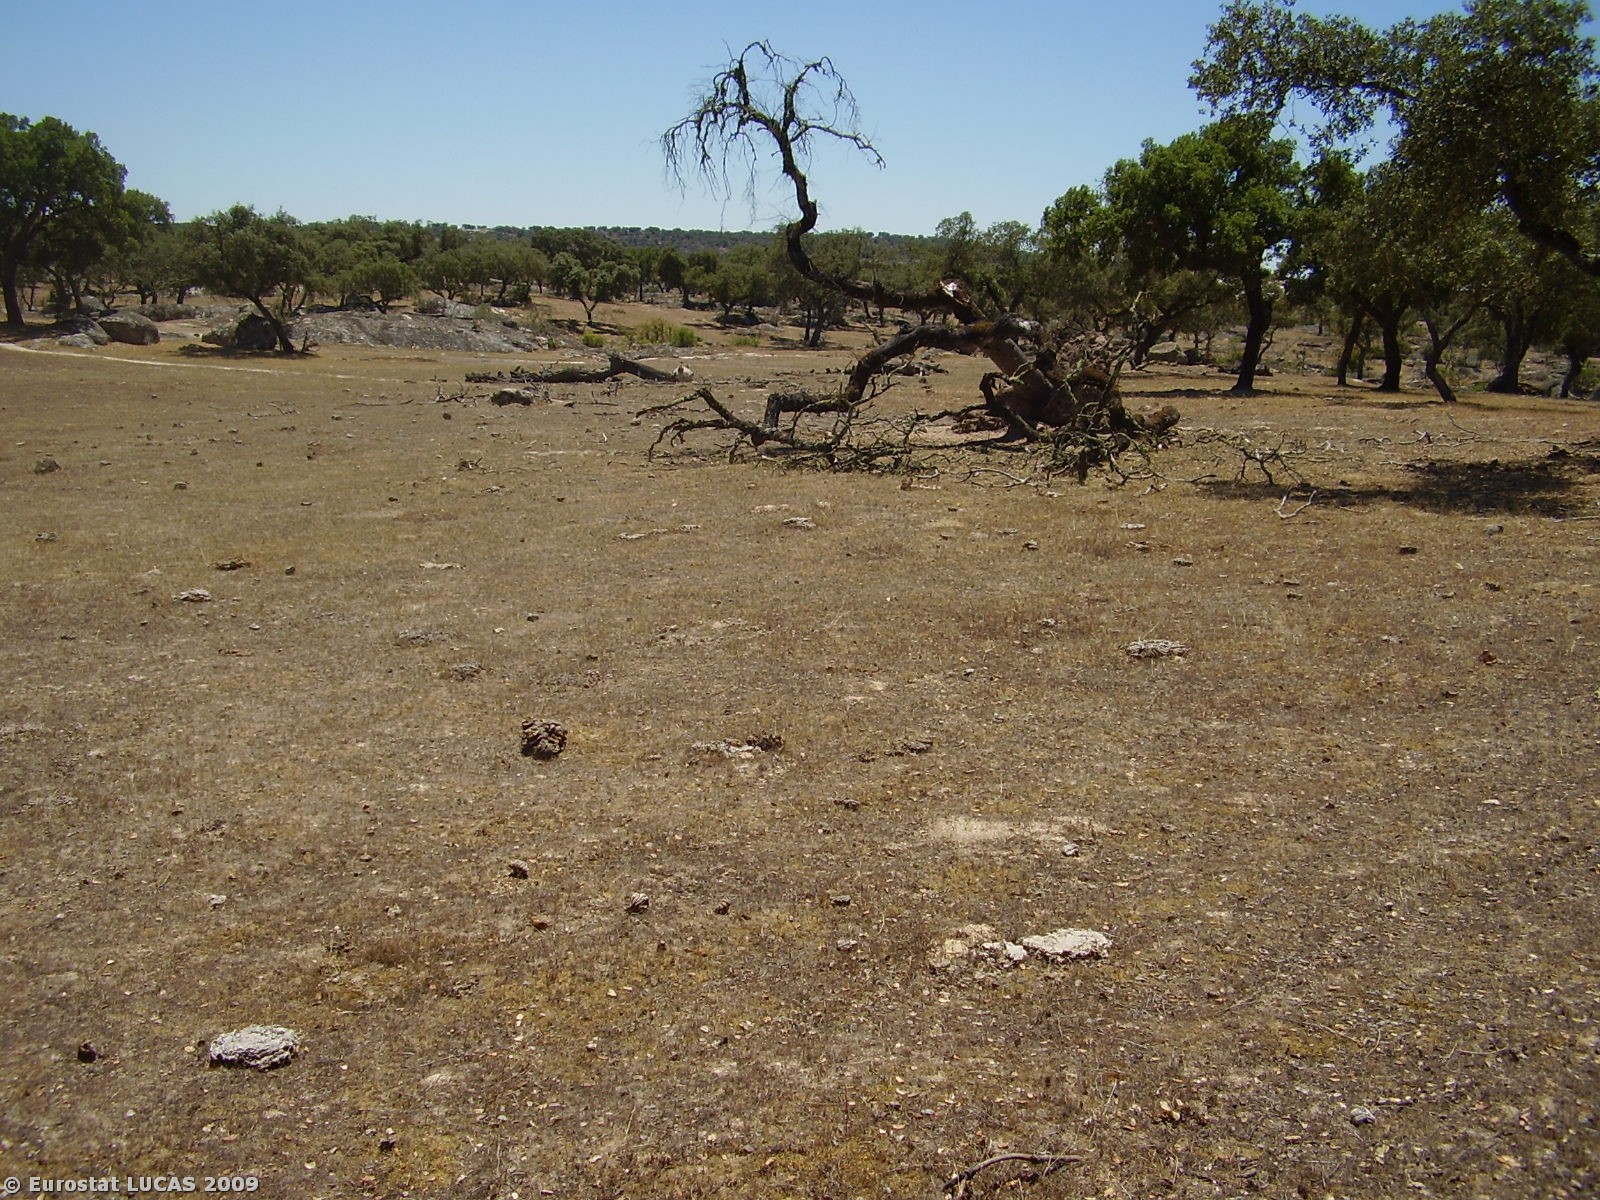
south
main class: Woodland
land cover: Broadleaved woodland
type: broadleaved evergreen forest
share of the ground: 10 - 25 %
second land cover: Grassland with sparse tree/shrub cover
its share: 50 - 75 %
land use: Forestry
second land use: Fallow land
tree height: > 5 m
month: July
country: PT
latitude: 38.8477
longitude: -7.8920
